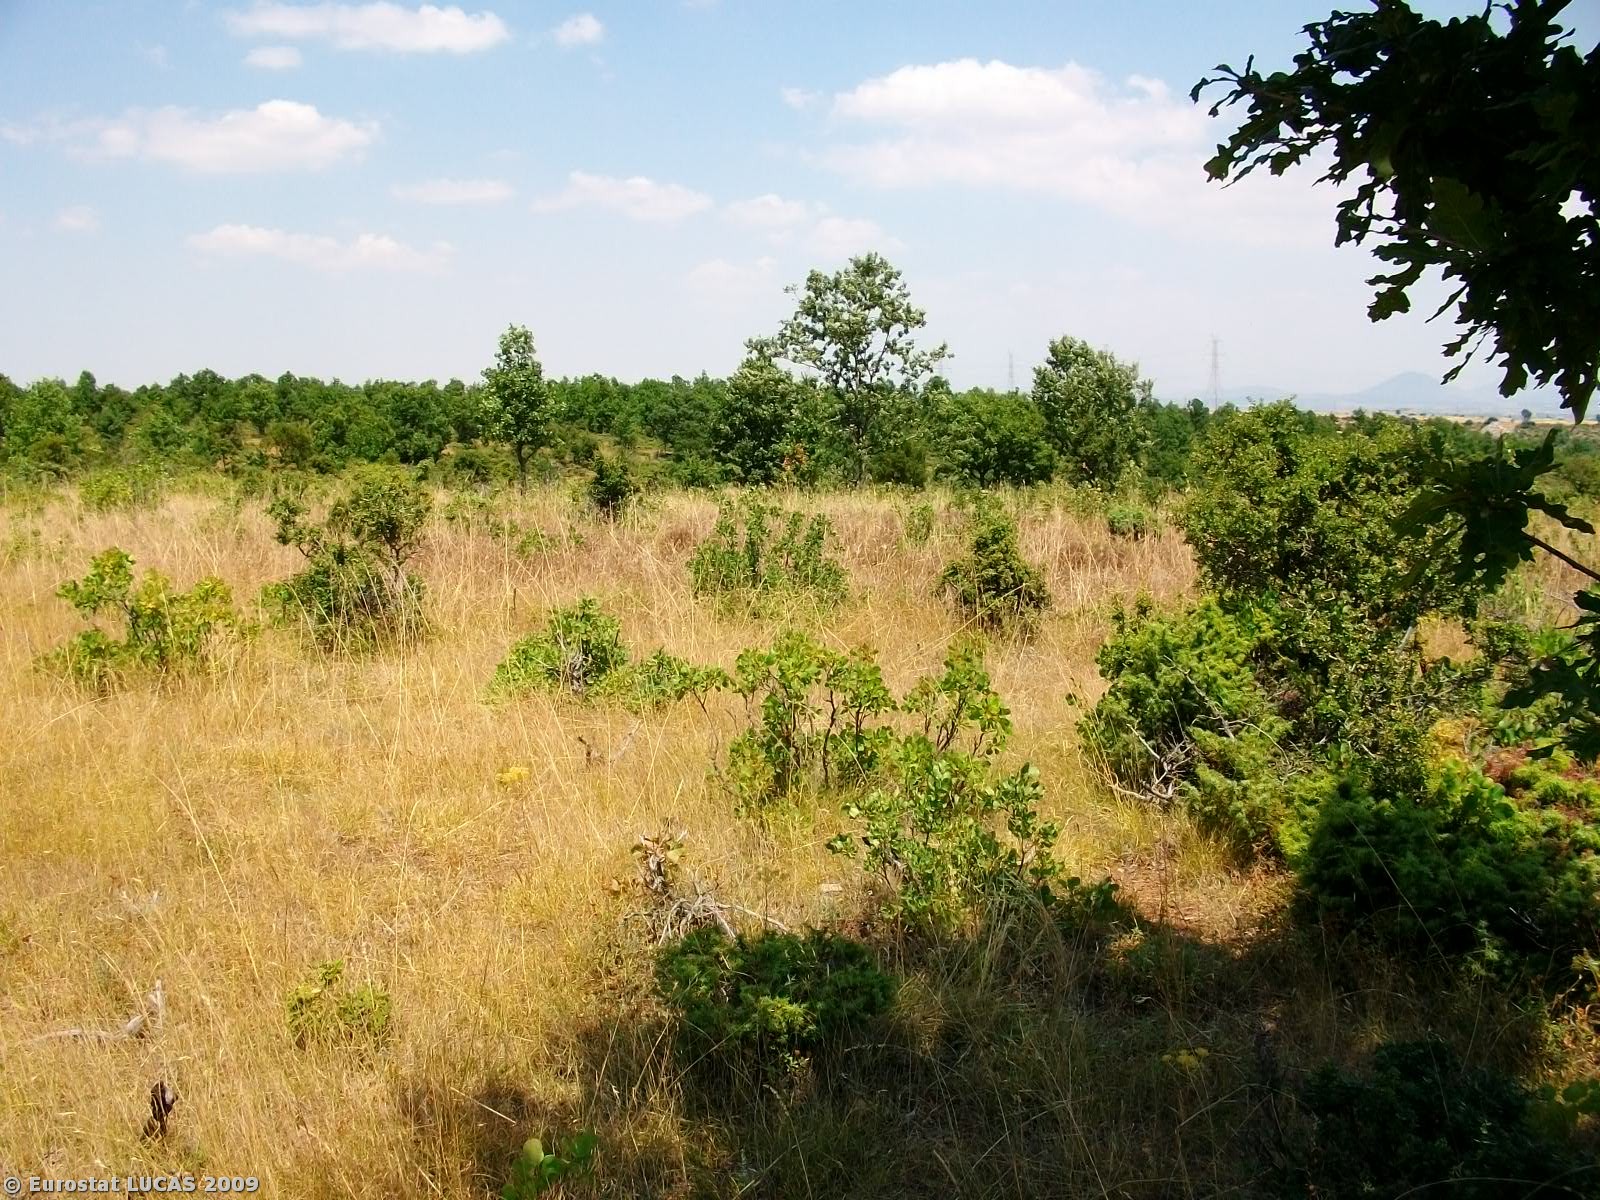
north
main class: Shrubland
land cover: Shrubland with sparse tree cover
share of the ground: 50 - 75 %
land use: Unused
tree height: > 5 m
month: July
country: GR
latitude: 40.1951
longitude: 21.7726
